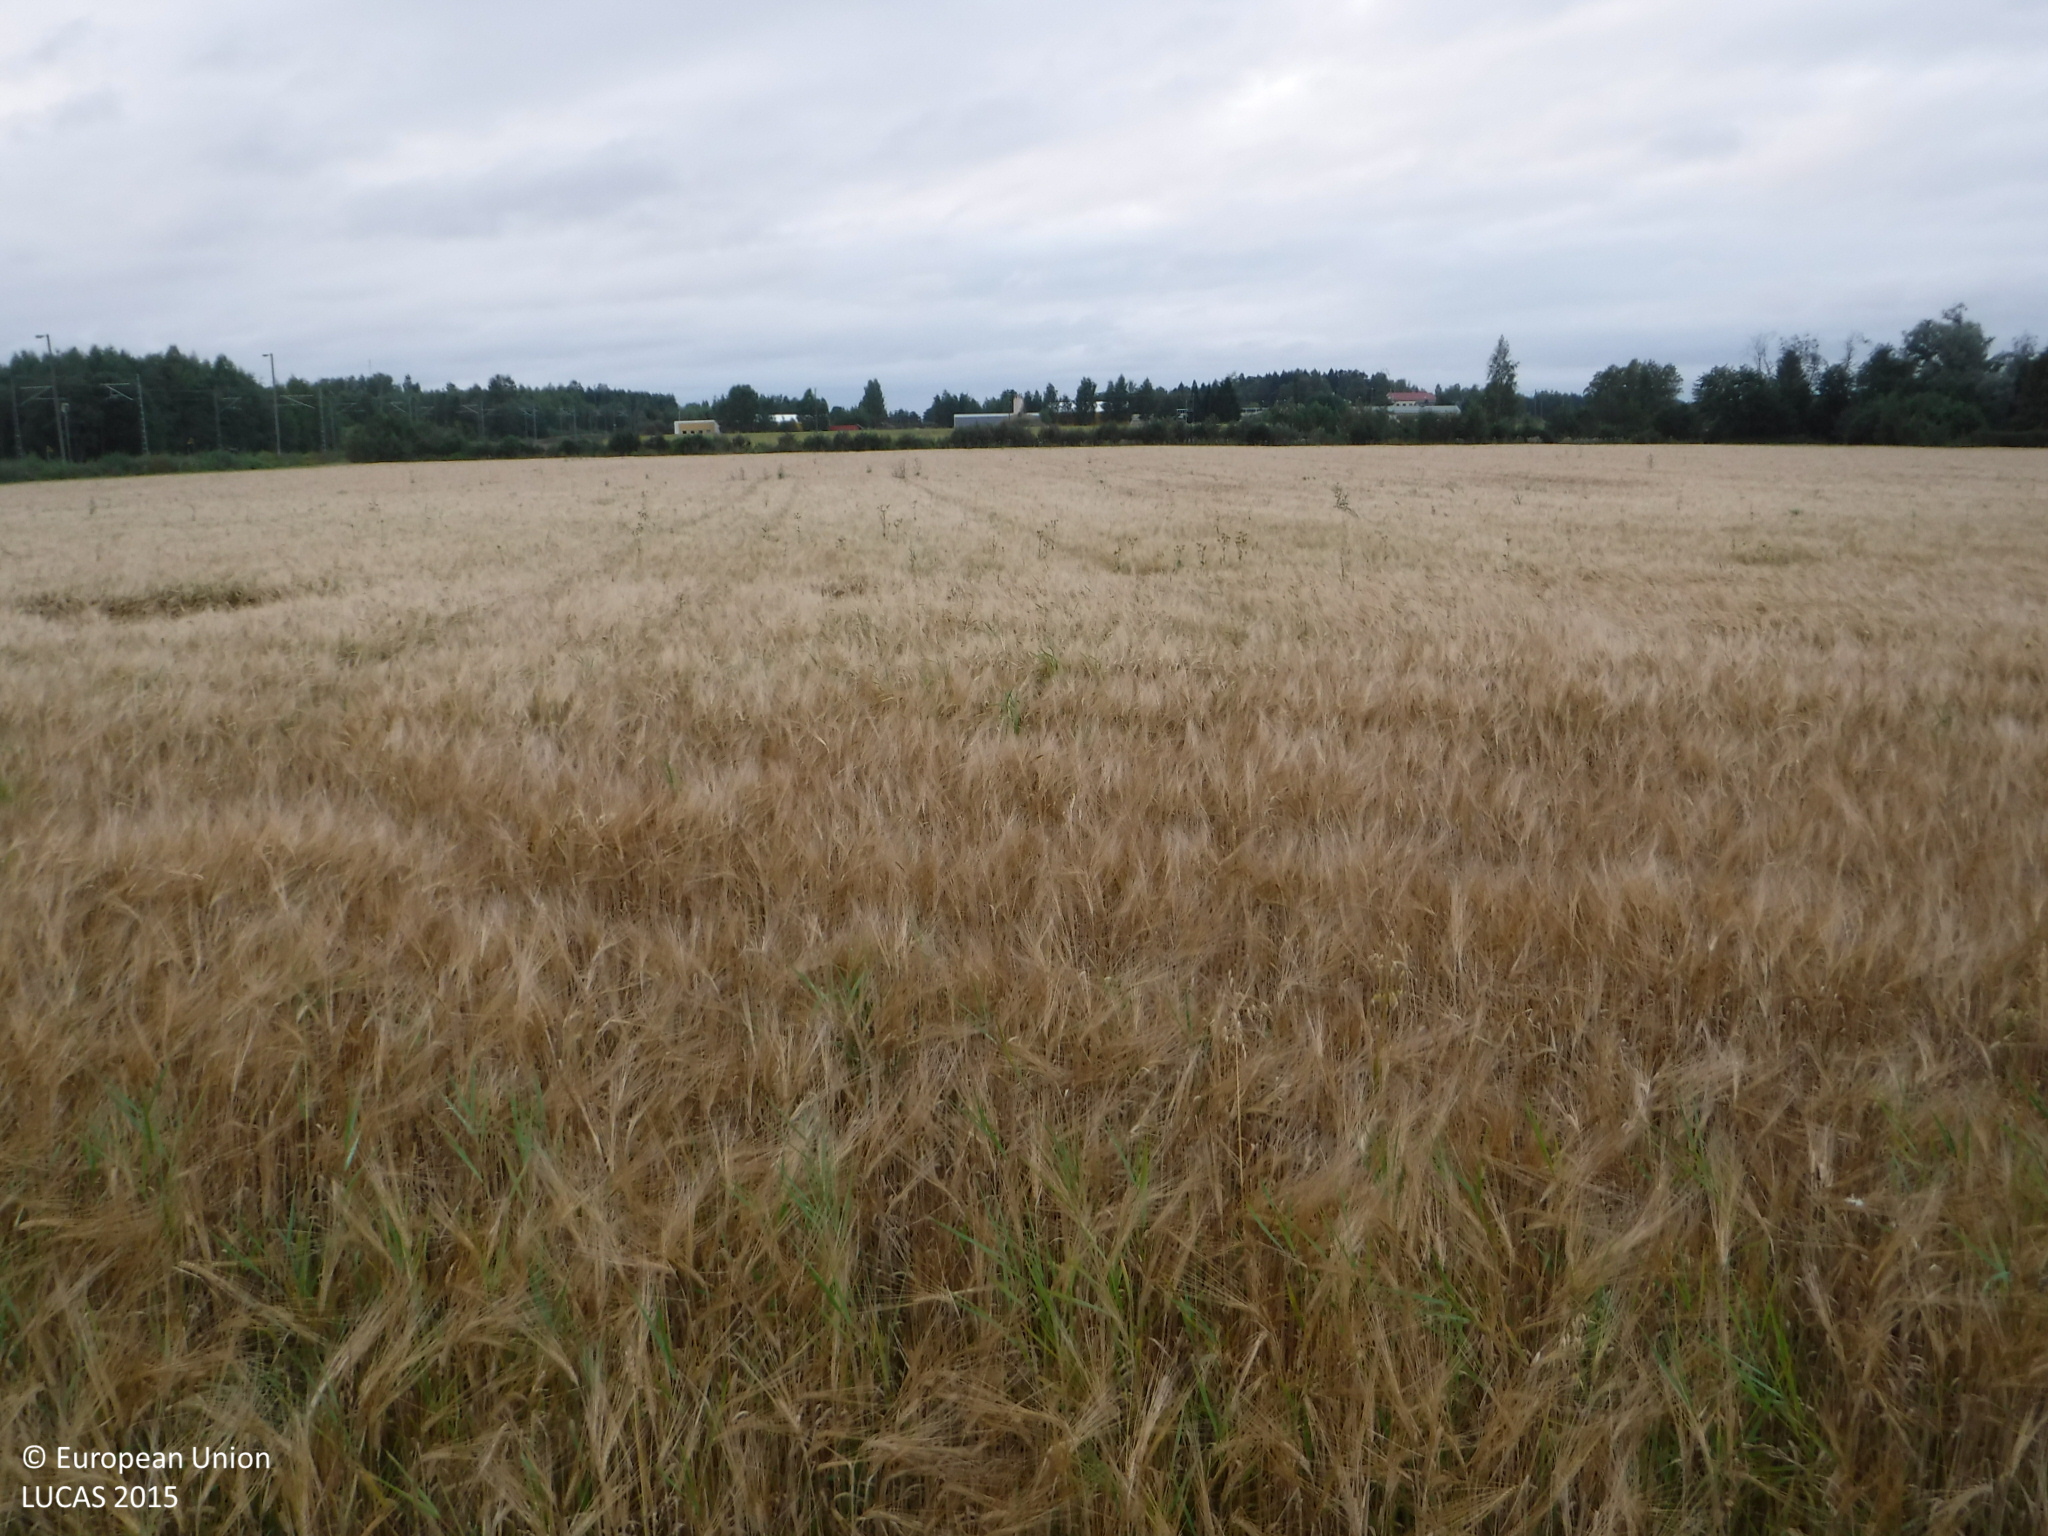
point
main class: Cropland
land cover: Barley
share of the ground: > 75 %
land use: Agriculture (excluding fallow land and kitchen gardens)
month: September
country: FI
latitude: 61.3833
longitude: 21.9796
